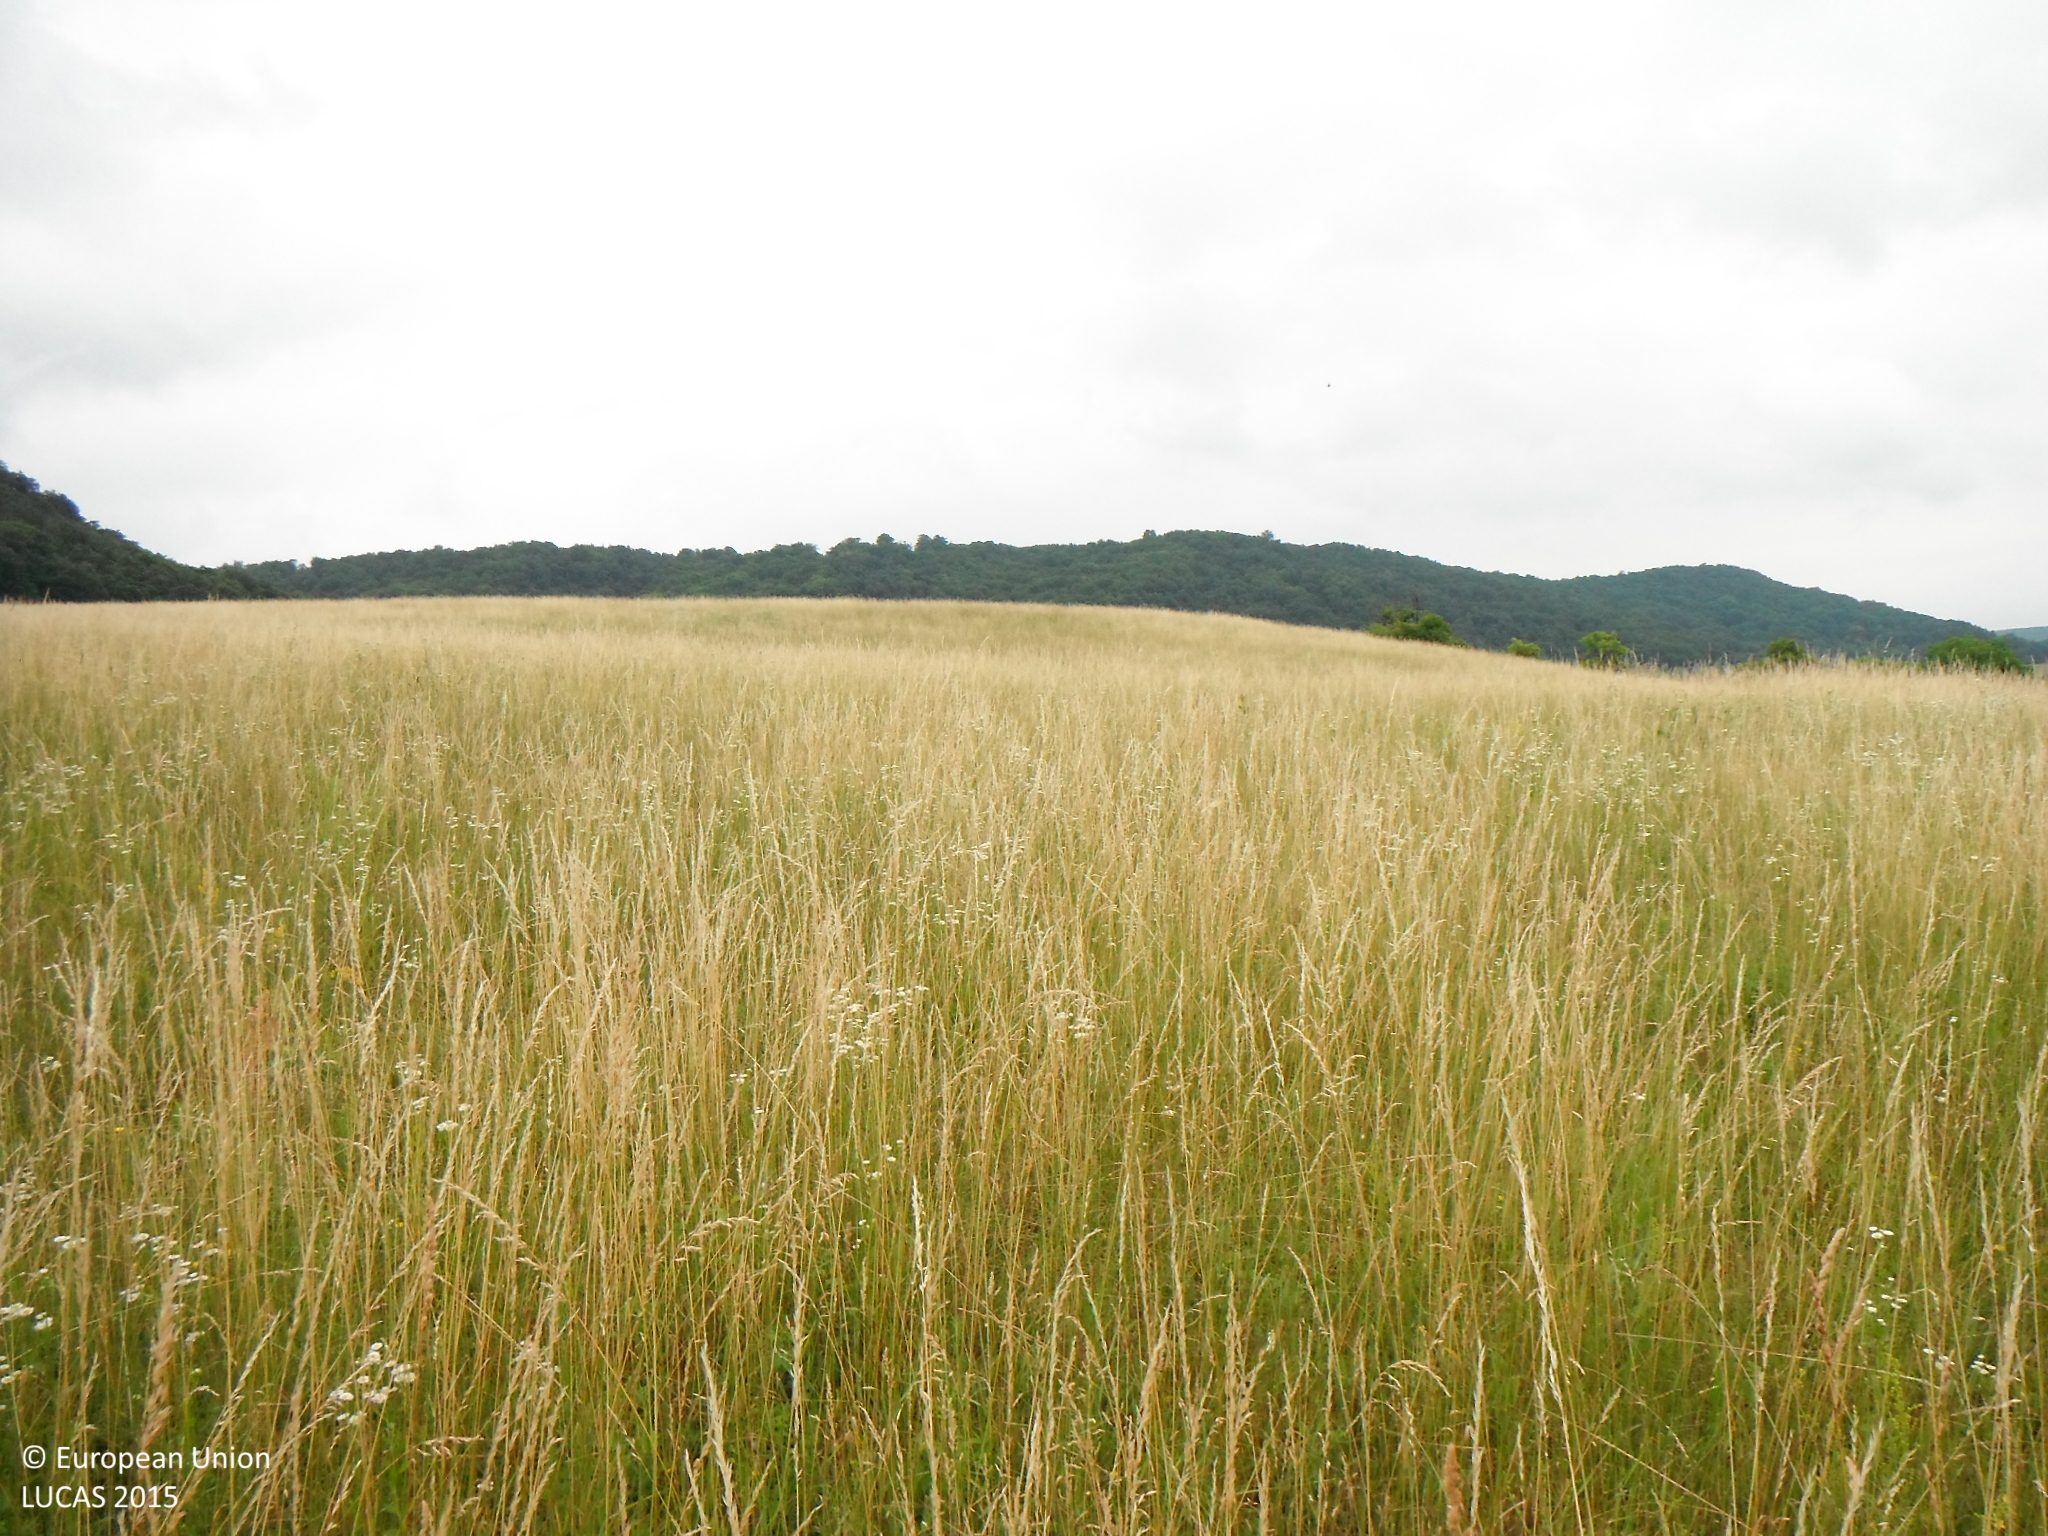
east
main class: Grassland
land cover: Grassland without tree/shrub cover
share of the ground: > 75 %
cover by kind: herbaceous plants 100 %
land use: Agriculture (excluding fallow land and kitchen gardens)
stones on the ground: < 10 %
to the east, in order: Grassland without tree/shrub cover
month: June
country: SK
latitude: 48.5007
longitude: 20.1135
